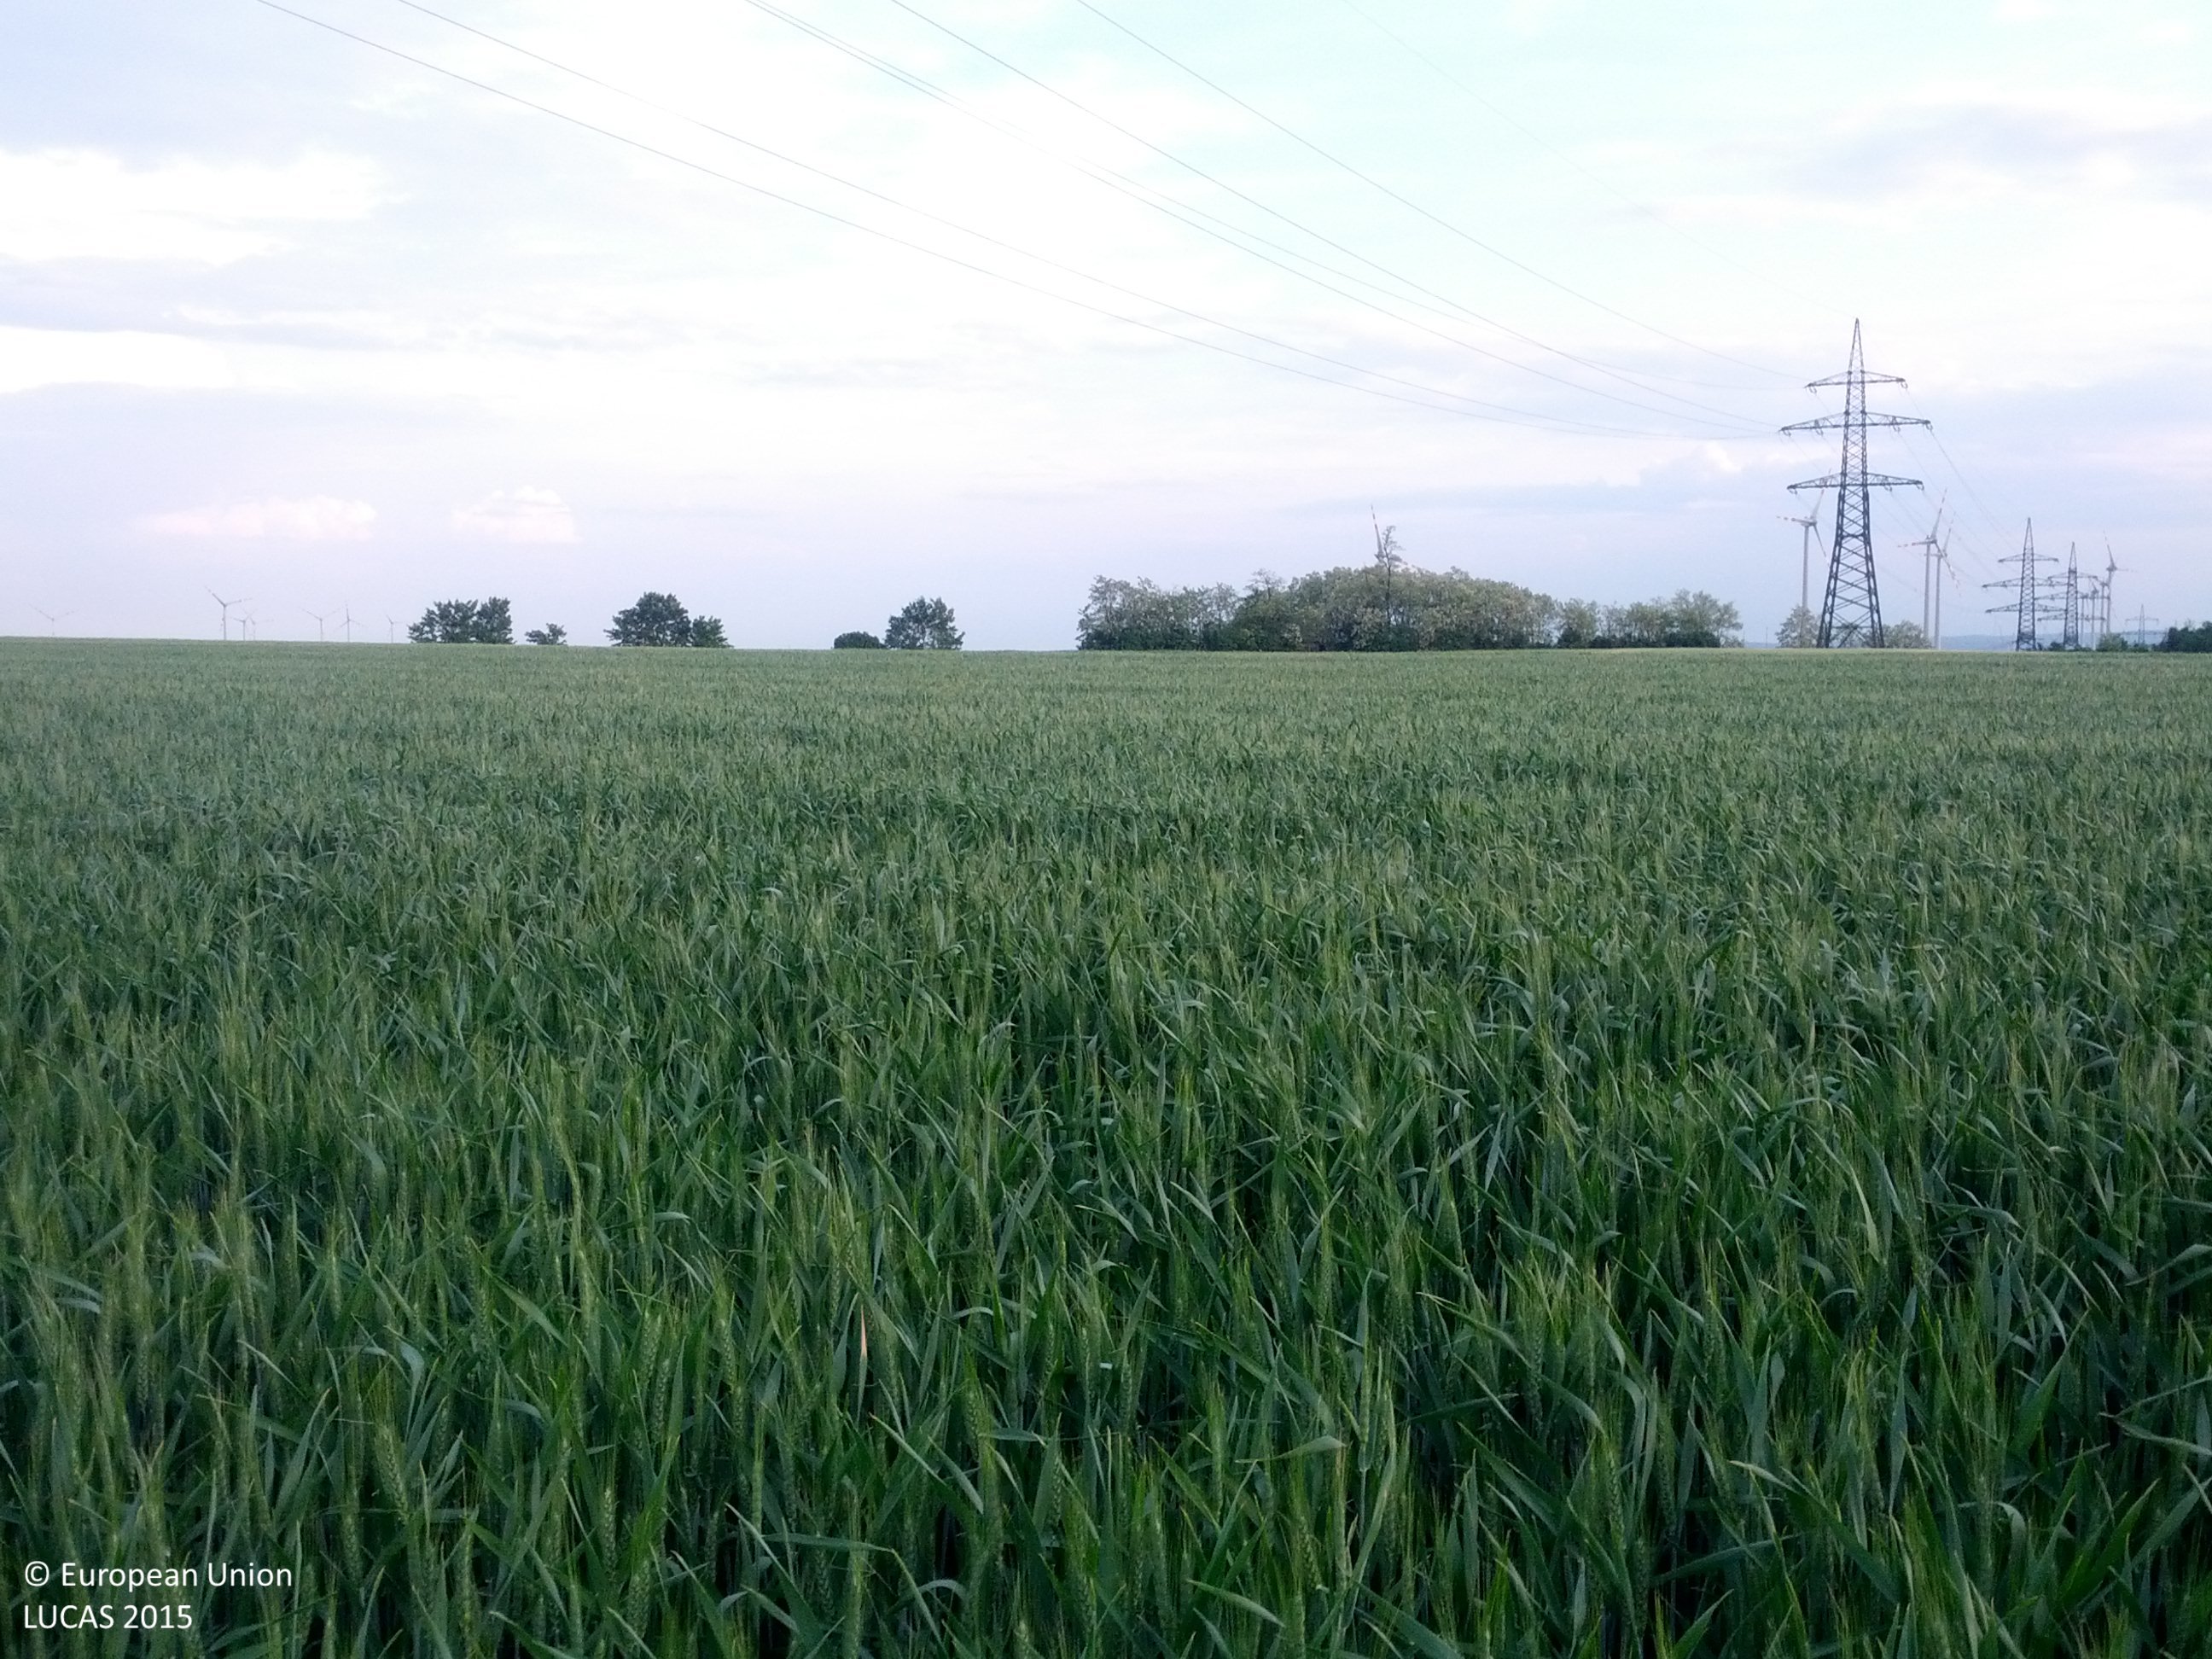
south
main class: Cropland
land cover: Common wheat
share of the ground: > 75 %
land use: Agriculture (excluding fallow land and kitchen gardens)
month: May
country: AT
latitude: 48.0995
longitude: 16.8686
